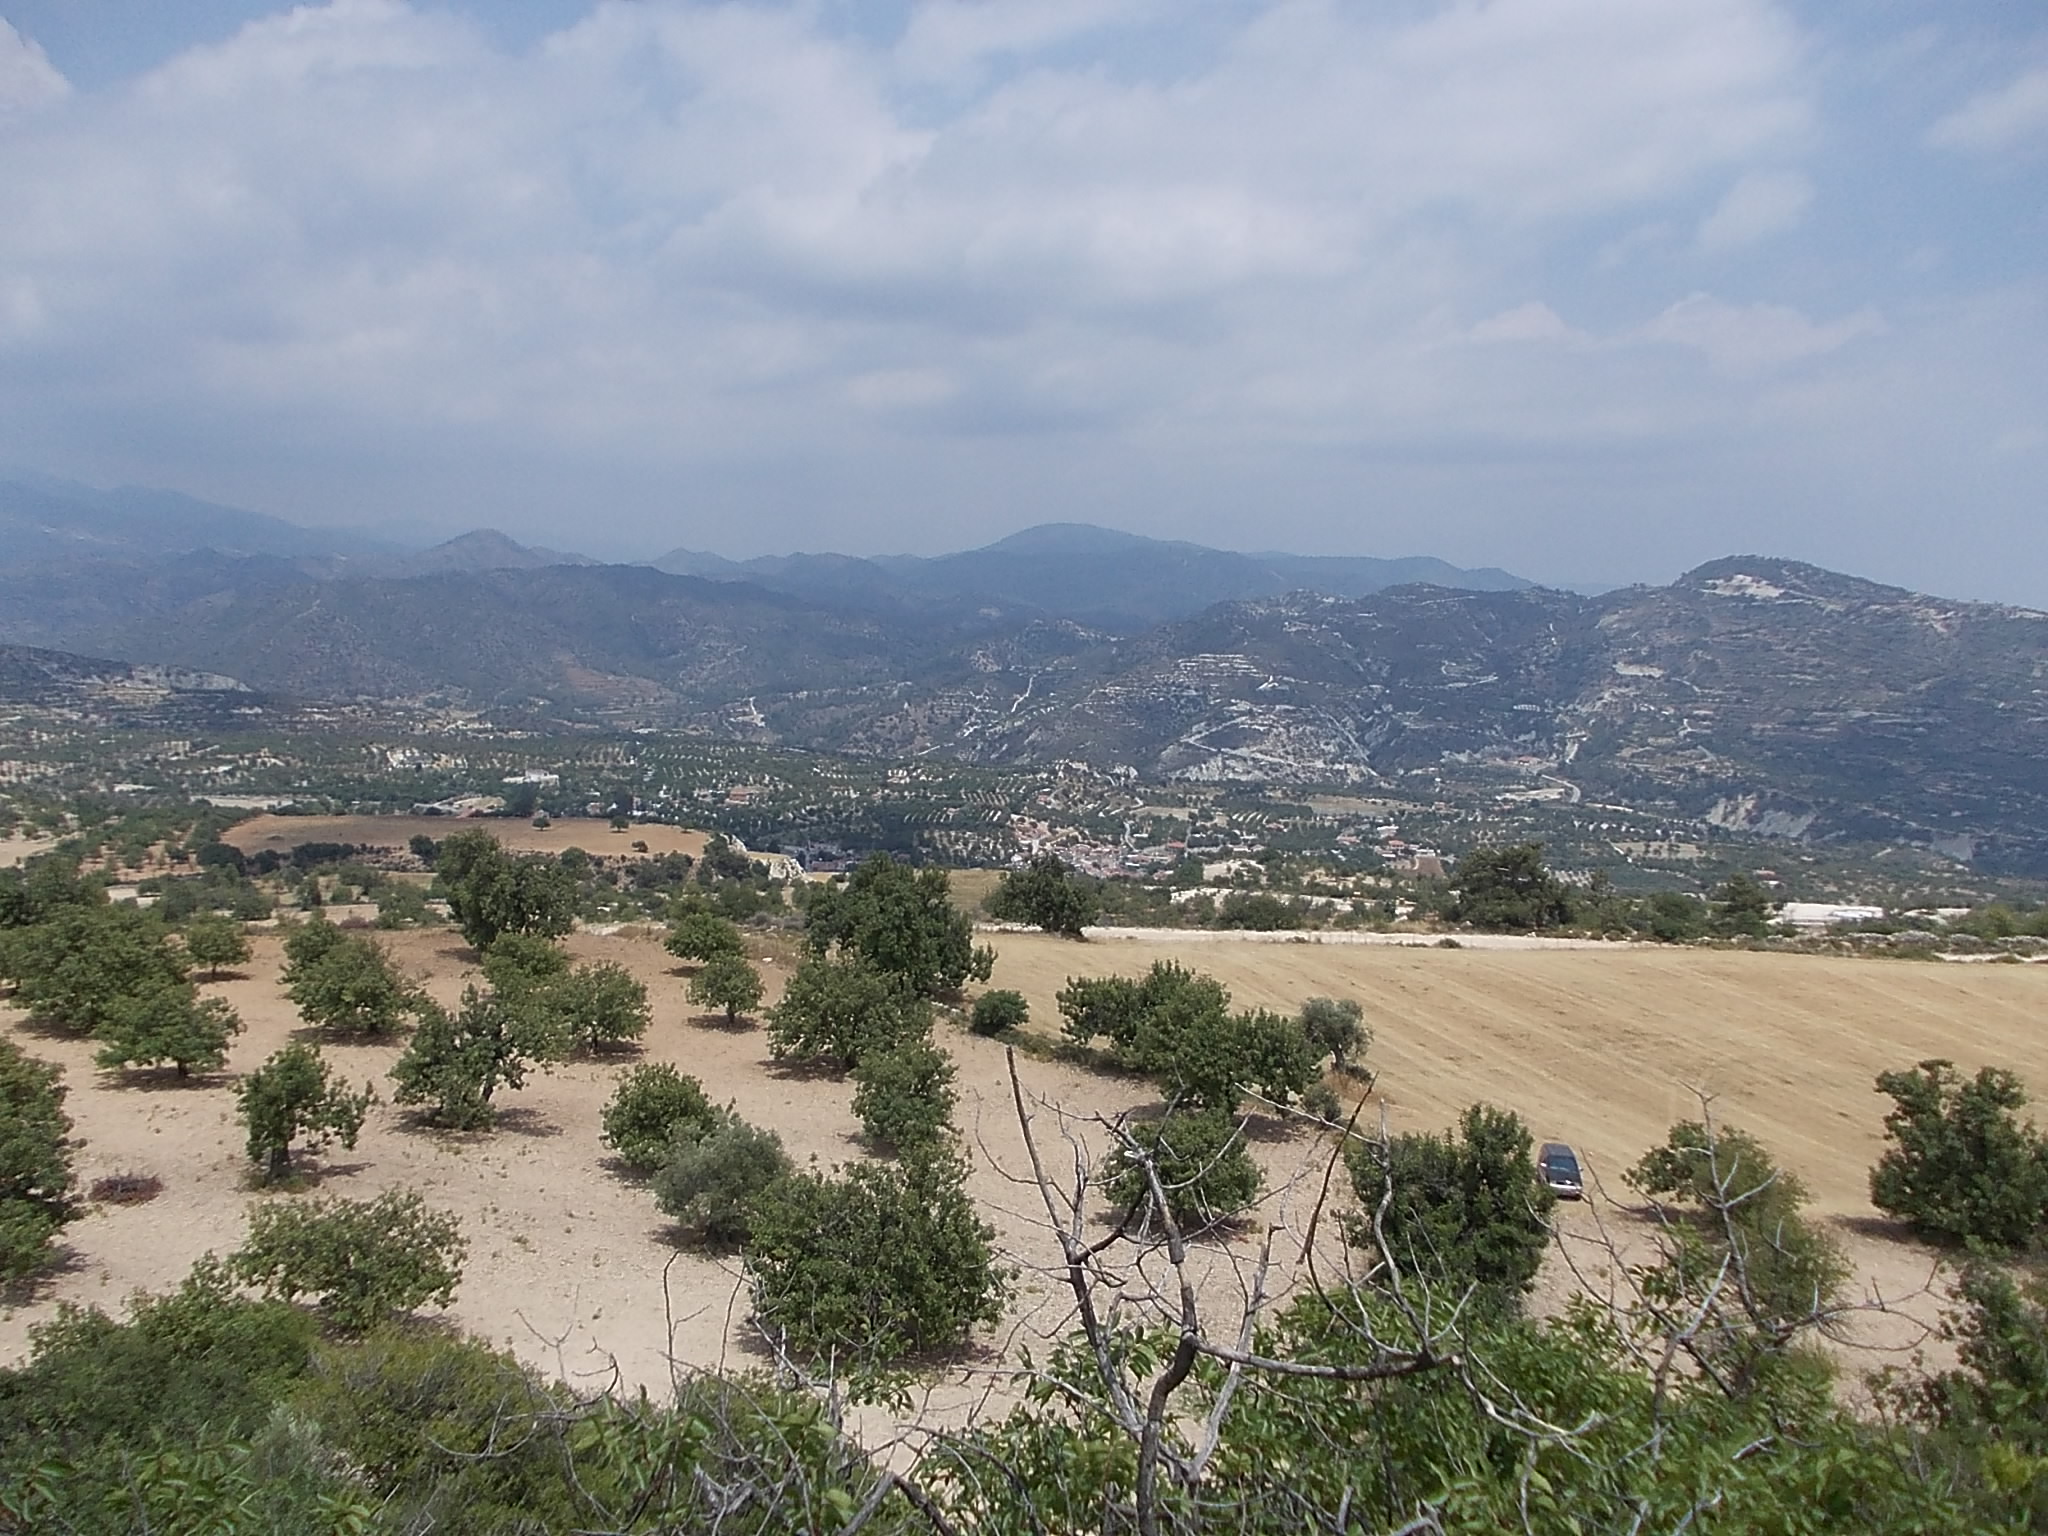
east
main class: Shrubland
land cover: Shrubland with sparse tree cover
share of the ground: 50 - 75 %
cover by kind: shrubs 55 %, unconsolidated bare surface 25 %, herbaceous plants 15 %, broadleaved forest trees 5 %
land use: Semi-natural and natural areas not in use
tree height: < 5 m
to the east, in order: Shrubland with sparse tree cover; Other bare soil; Other fruit trees and berries; Managed hedges; Other bare soil; Grass margins; Paved roads, cycling and walking lanes; Shrubland with sparse tree cover; Nuts trees; Dry stone walls; Nuts trees; Dry stone walls; Nuts trees; Paved roads, cycling and walking lanes; Shrubland with sparse tree cover; Nuts trees; Shrubland with sparse tree cover; Dry stone walls
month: June
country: CY
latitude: 34.8104
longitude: 32.9355
